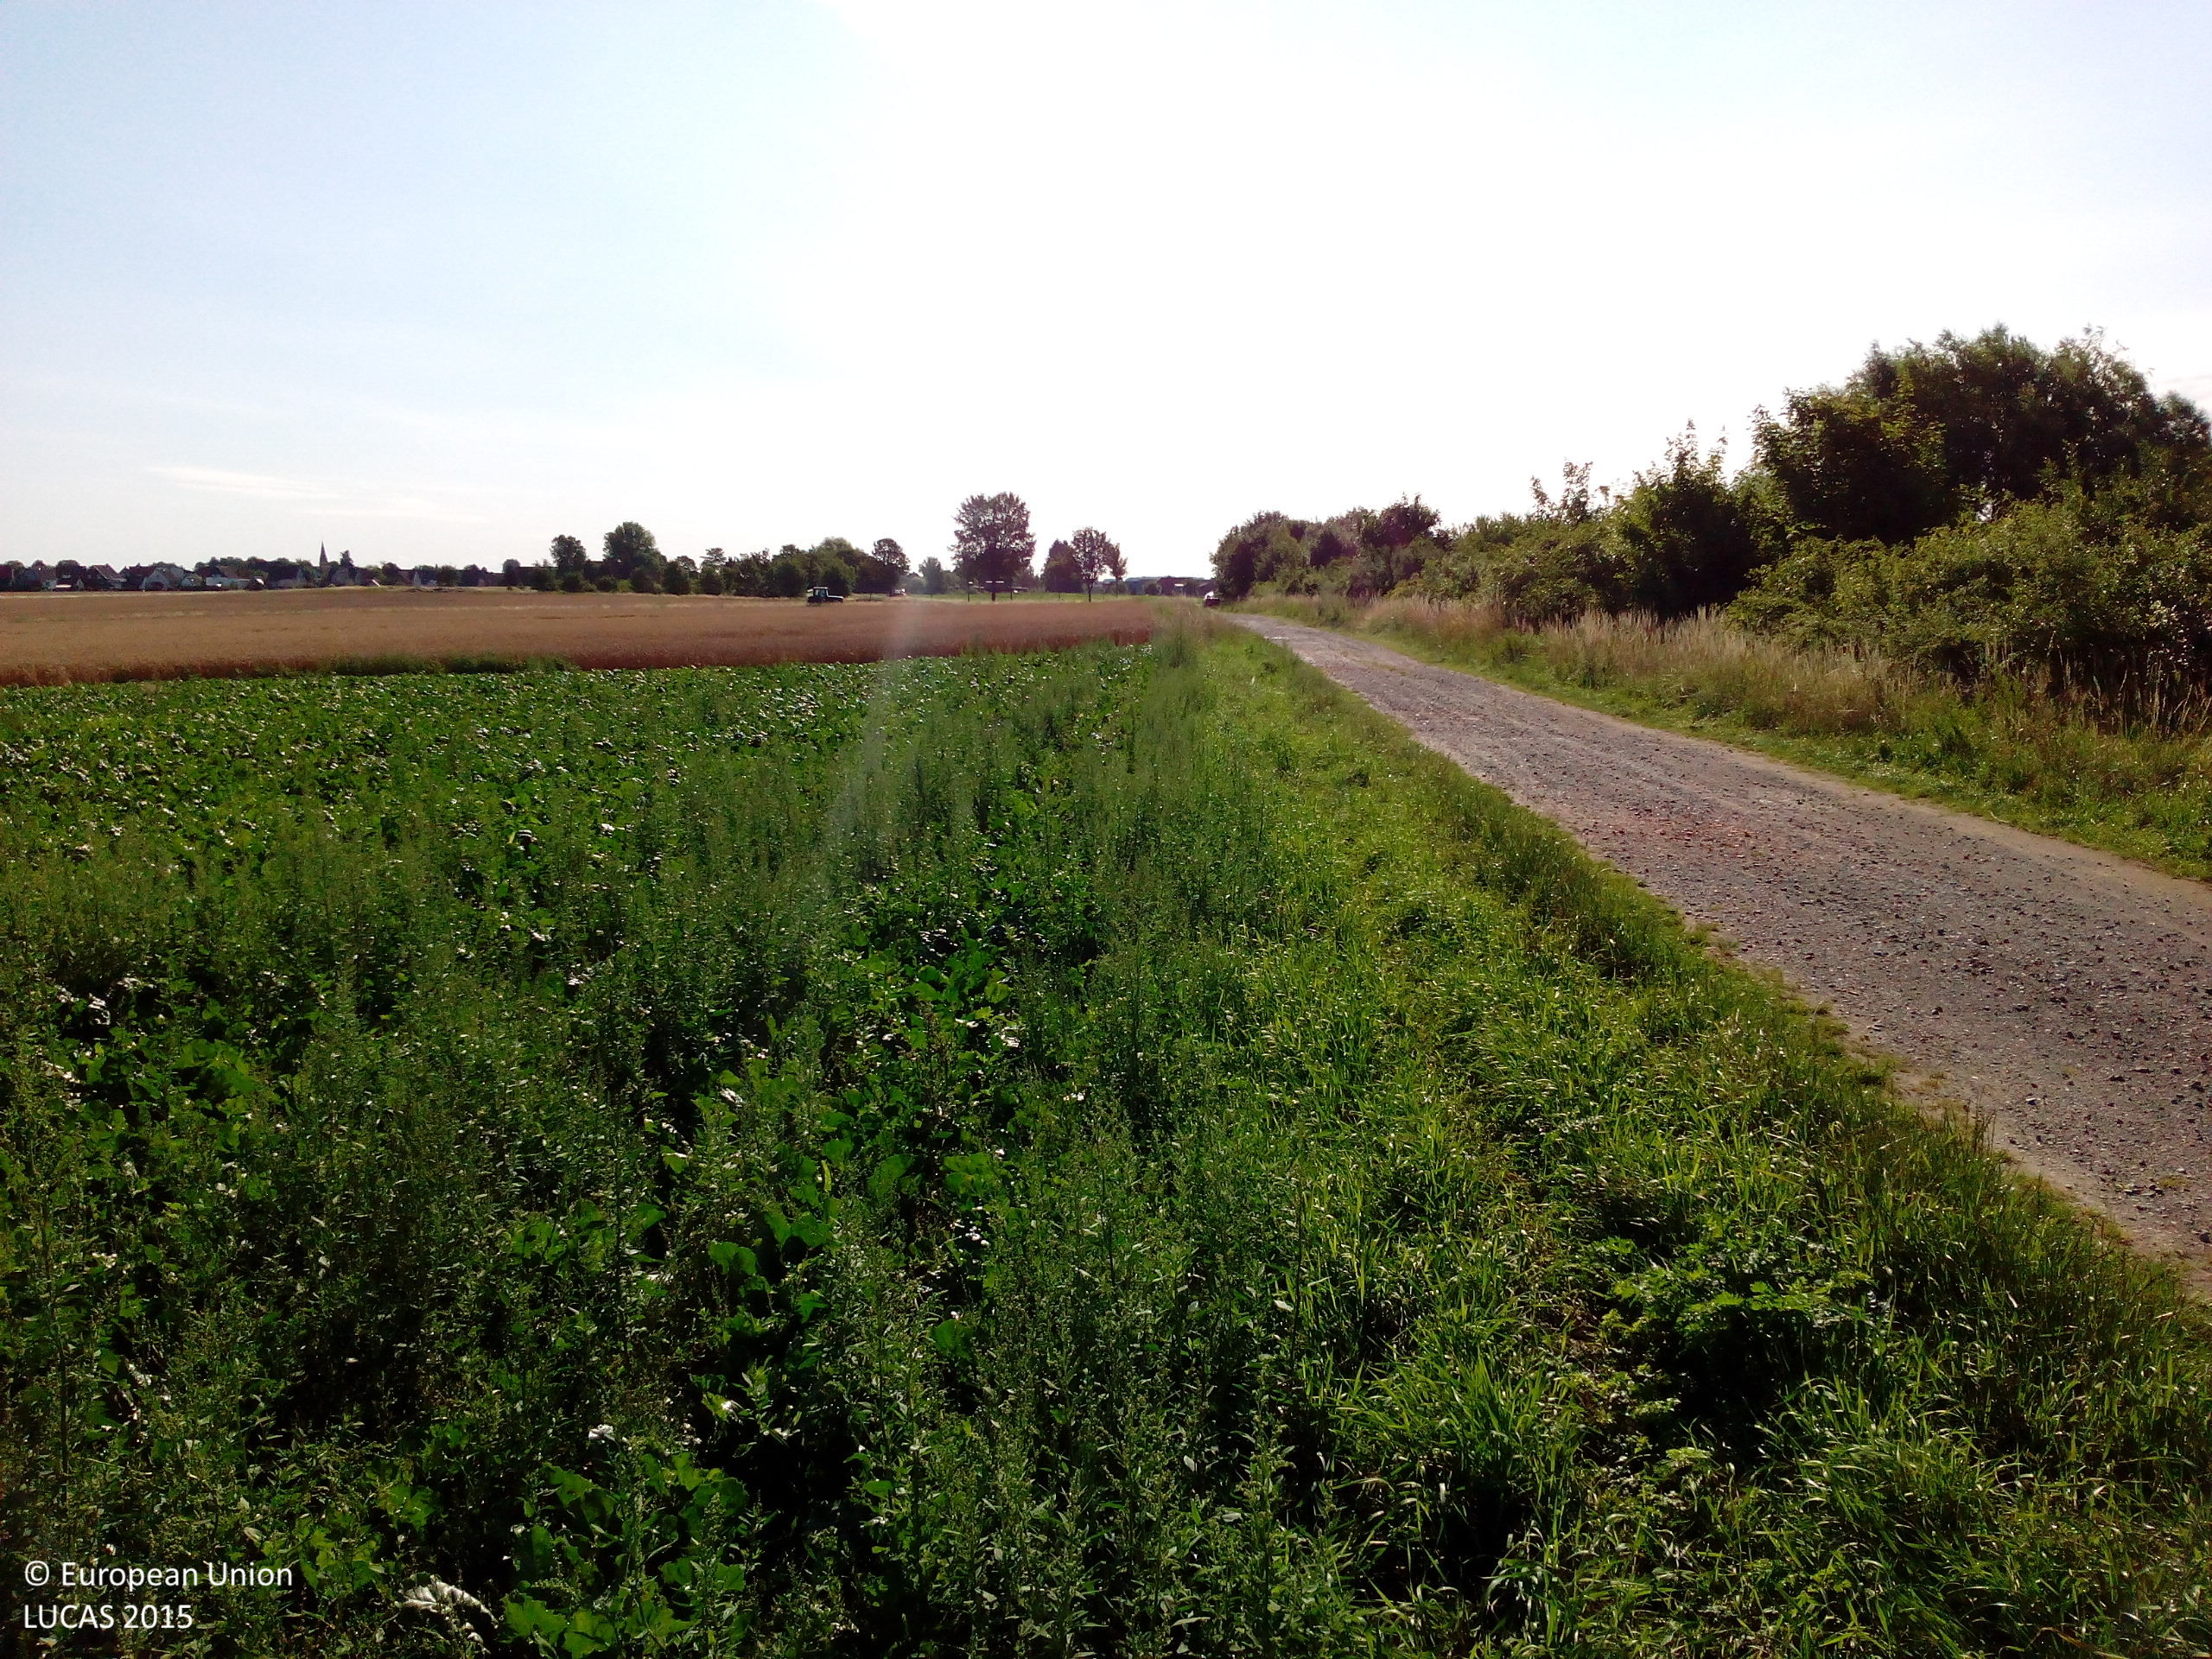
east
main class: Cropland
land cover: Sugar beet
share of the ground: > 75 %
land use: Agriculture (excluding fallow land and kitchen gardens)
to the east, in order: Sugar beet; Common wheat; Sugar beet; Grass margins; Paved roads, cycling and walking lanes; Grass margins; Common wheat
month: July
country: DE
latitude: 52.3412
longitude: 10.2788
